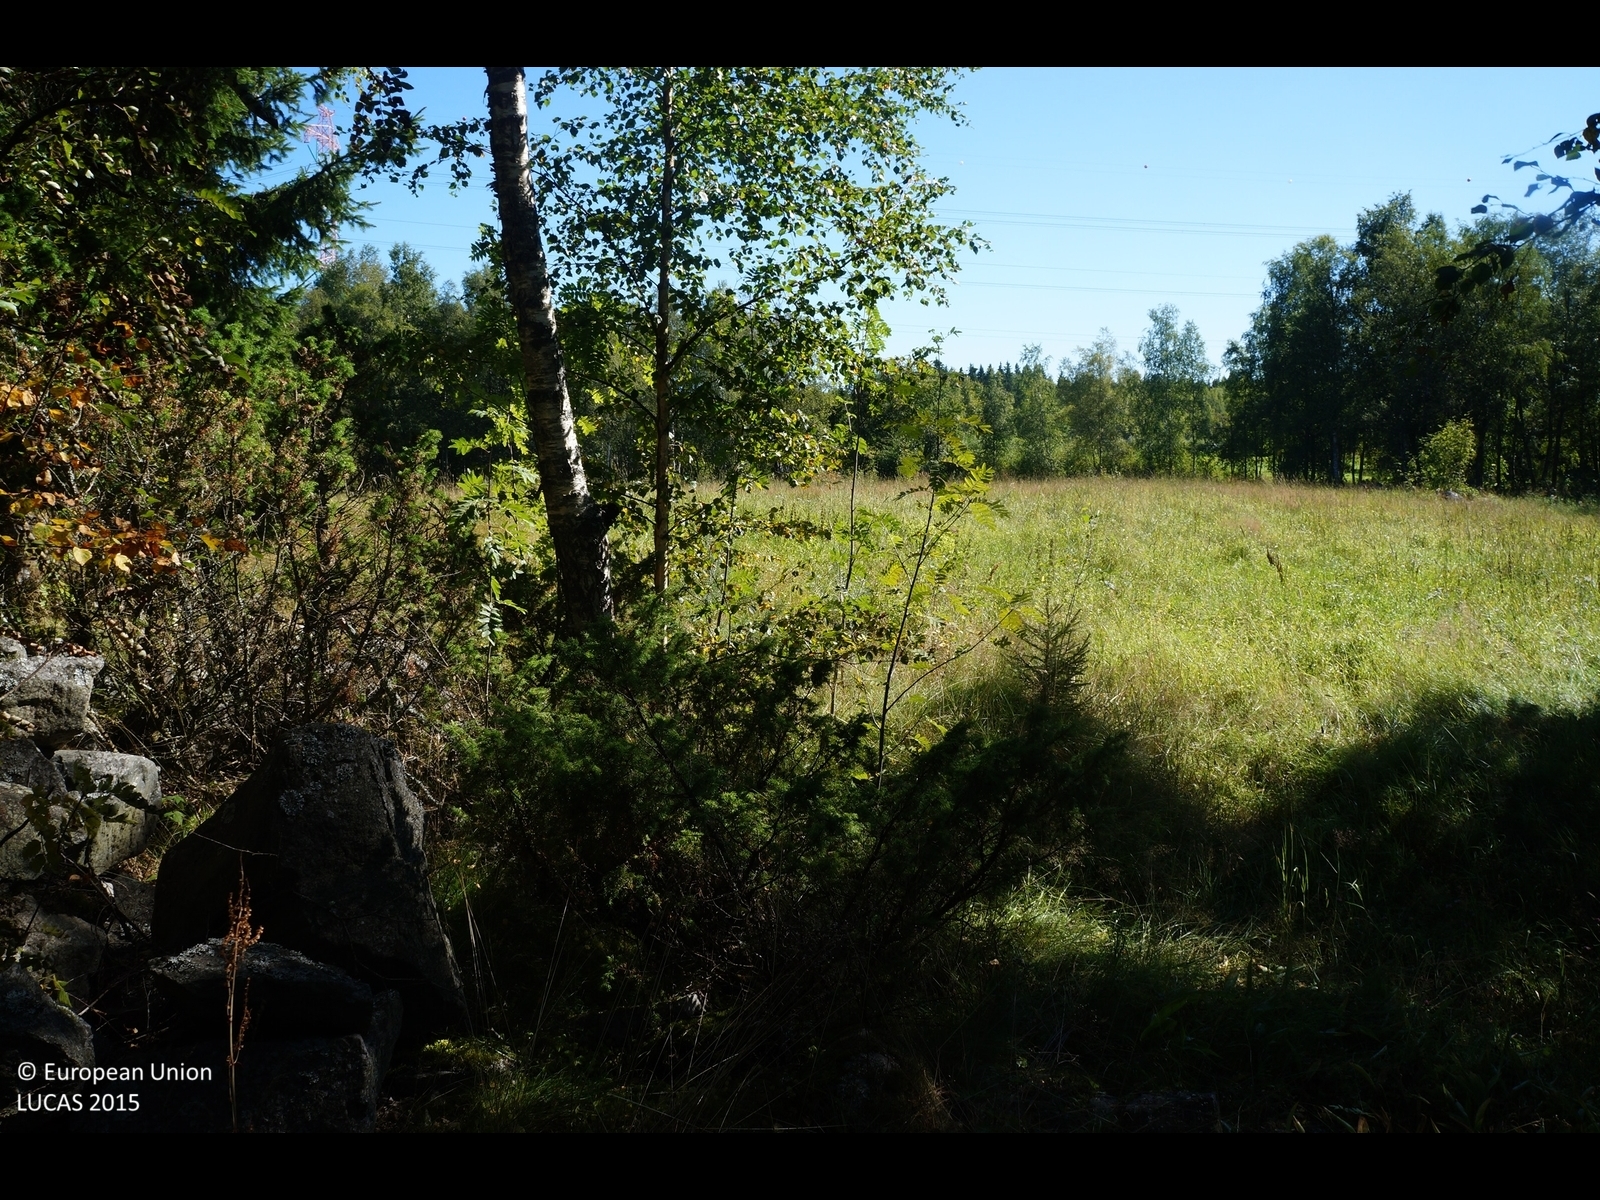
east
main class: Woodland
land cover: Spruce dominated mixed woodland
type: boreal forest
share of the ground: 50 - 75 %
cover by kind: coniferous forest trees 50 %, broadleaved forest trees 20 %, lichens and mosses 10 %, consolidated bare surface 10 %, shrubs 5 %, herbaceous plants 5 %
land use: Forestry
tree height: > 5 m
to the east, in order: Spruce dominated mixed woodland; Grassland without tree/shrub cover; Ditches and canals; Grassland without tree/shrub cover; Ditches and canals; Broadleaved woodland; Dry stone walls; Broadleaved woodland; Spruce dominated mixed woodland; Shrubland without tree cover; Electric lines; Shrubland without tree cover; Electric lines; Shrubland without tree cover
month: August
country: FI
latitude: 63.7506
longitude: 23.0015
